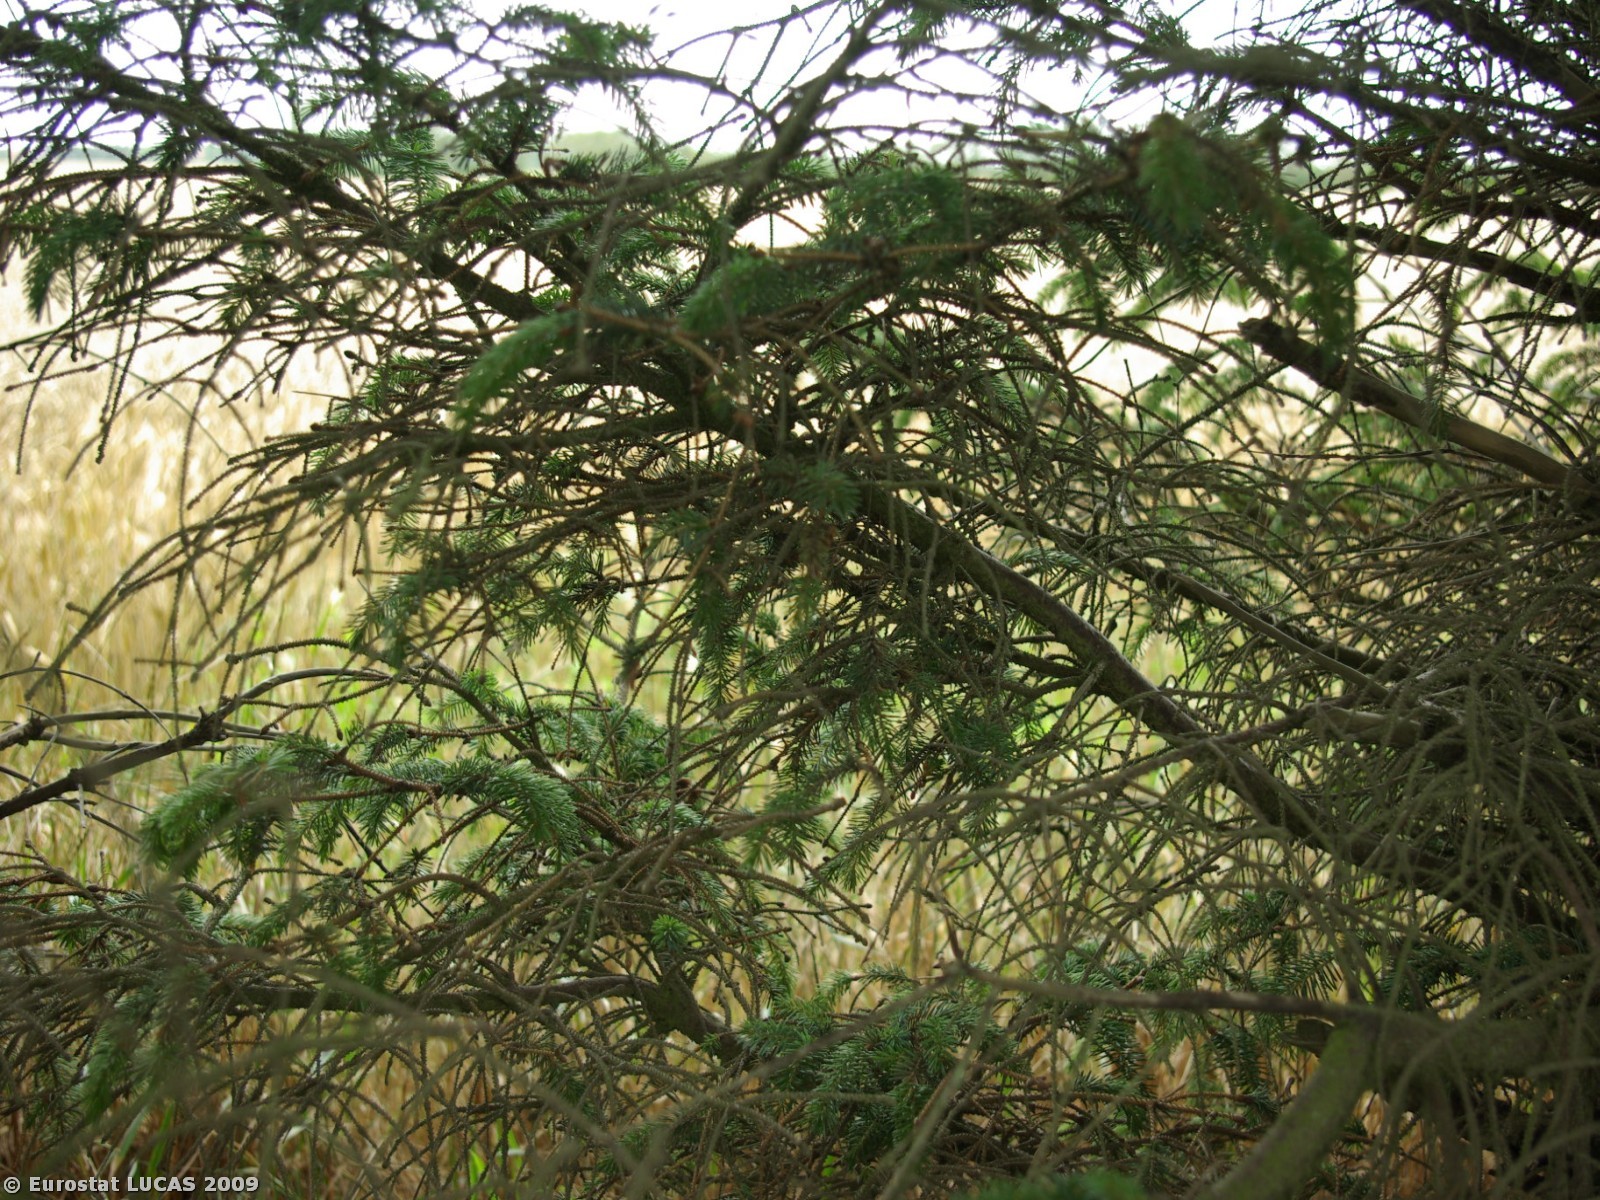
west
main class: Woodland
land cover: Coniferous woodland
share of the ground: 25 - 50 %
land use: Unused
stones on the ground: < 10 %
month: July
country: DK
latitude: 55.1218
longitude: 8.8249
